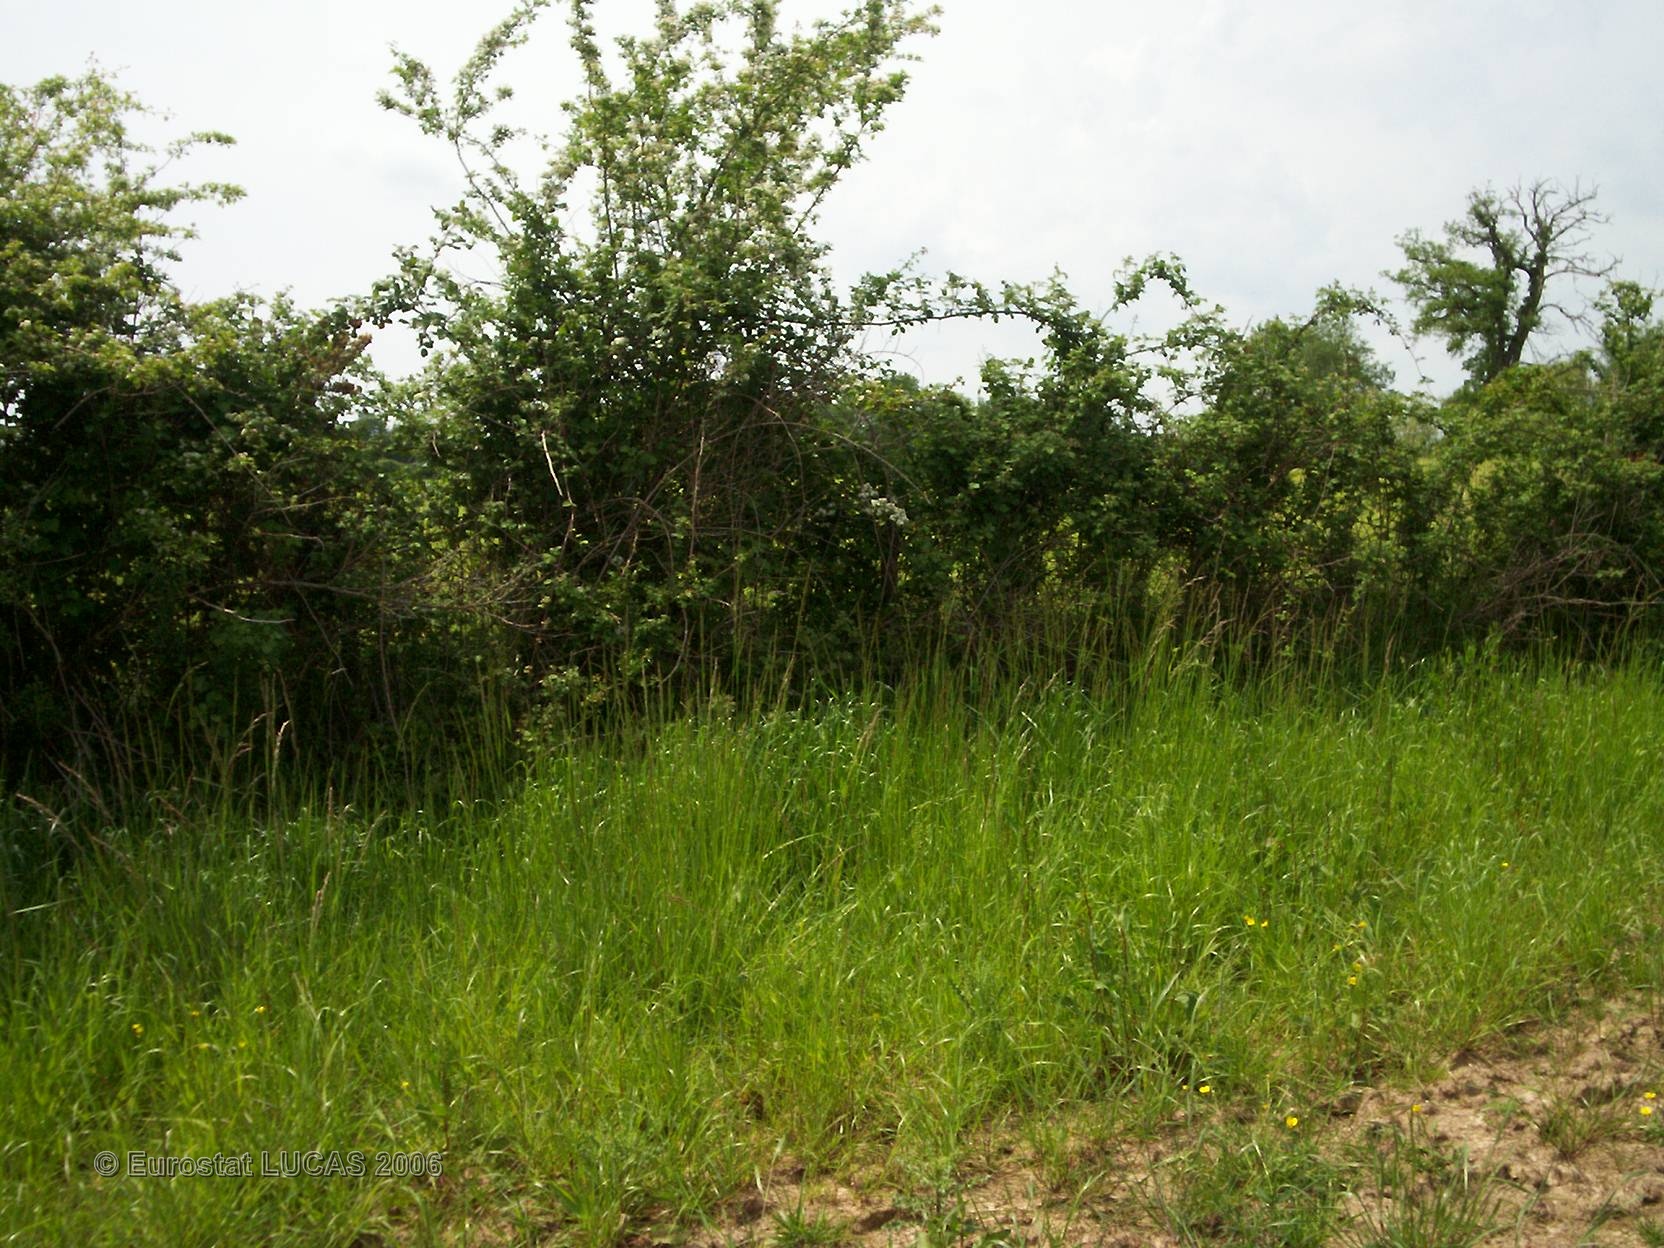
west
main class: Grassland
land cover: Grassland without tree/shrub cover
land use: Agriculture (excluding fallow land and kitchen gardens)
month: May
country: FR
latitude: 46.7517
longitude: 1.0184
